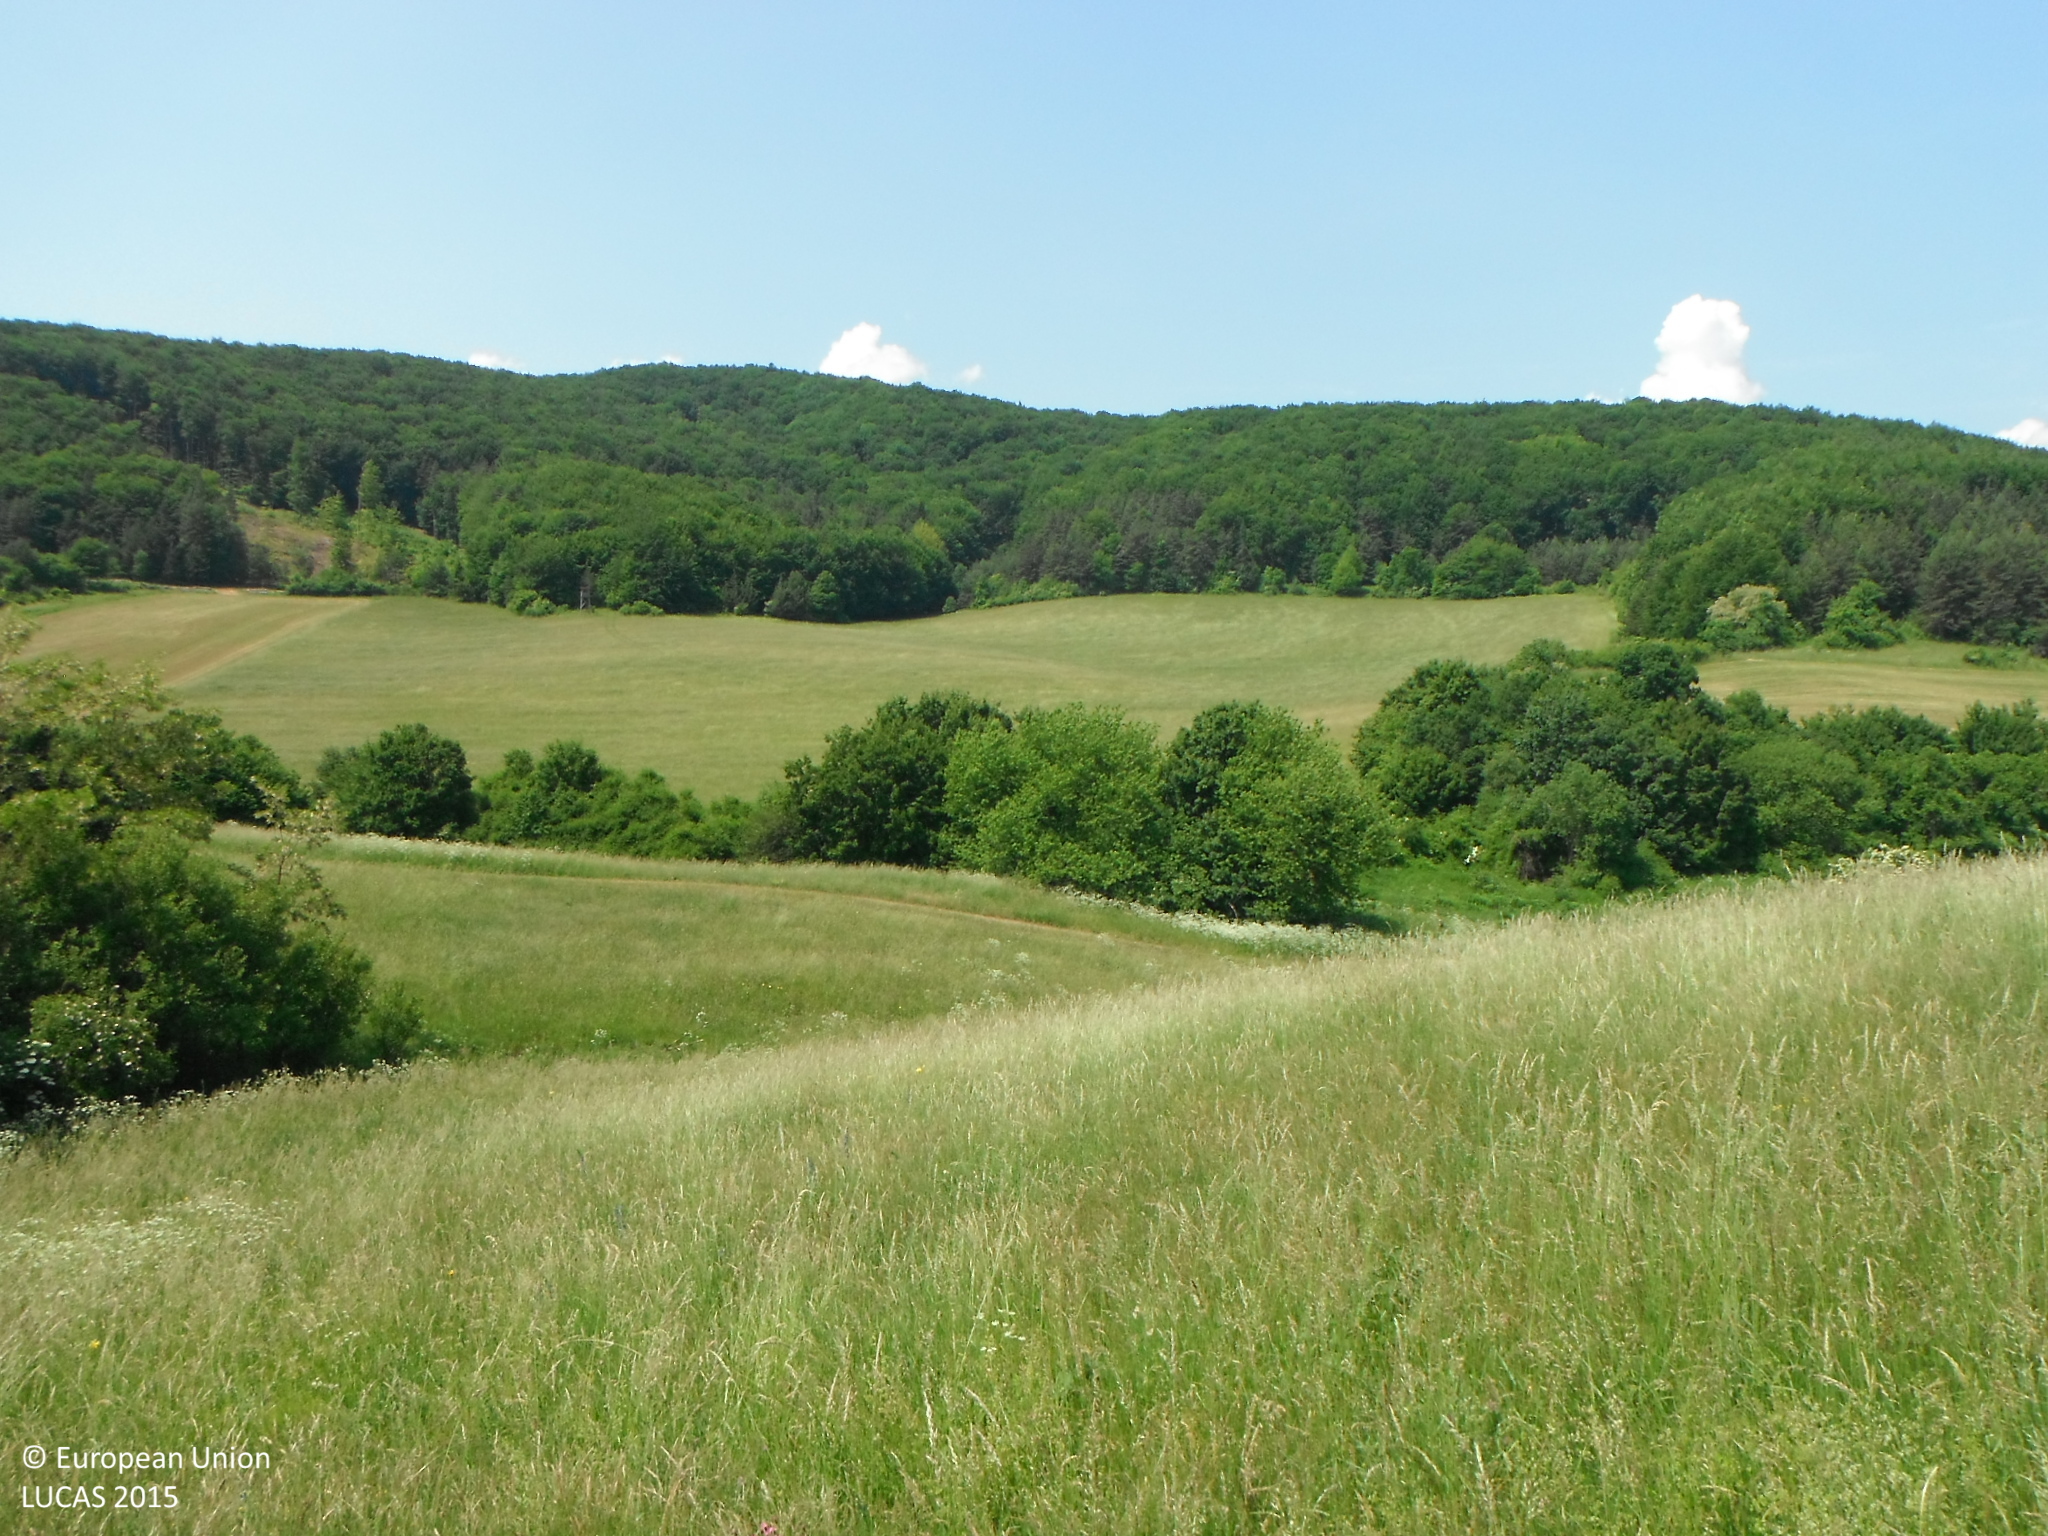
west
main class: Grassland
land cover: Grassland without tree/shrub cover
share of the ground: > 75 %
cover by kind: herbaceous plants 100 %
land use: Agriculture (excluding fallow land and kitchen gardens)
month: June
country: SK
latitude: 48.7077
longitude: 19.1955
